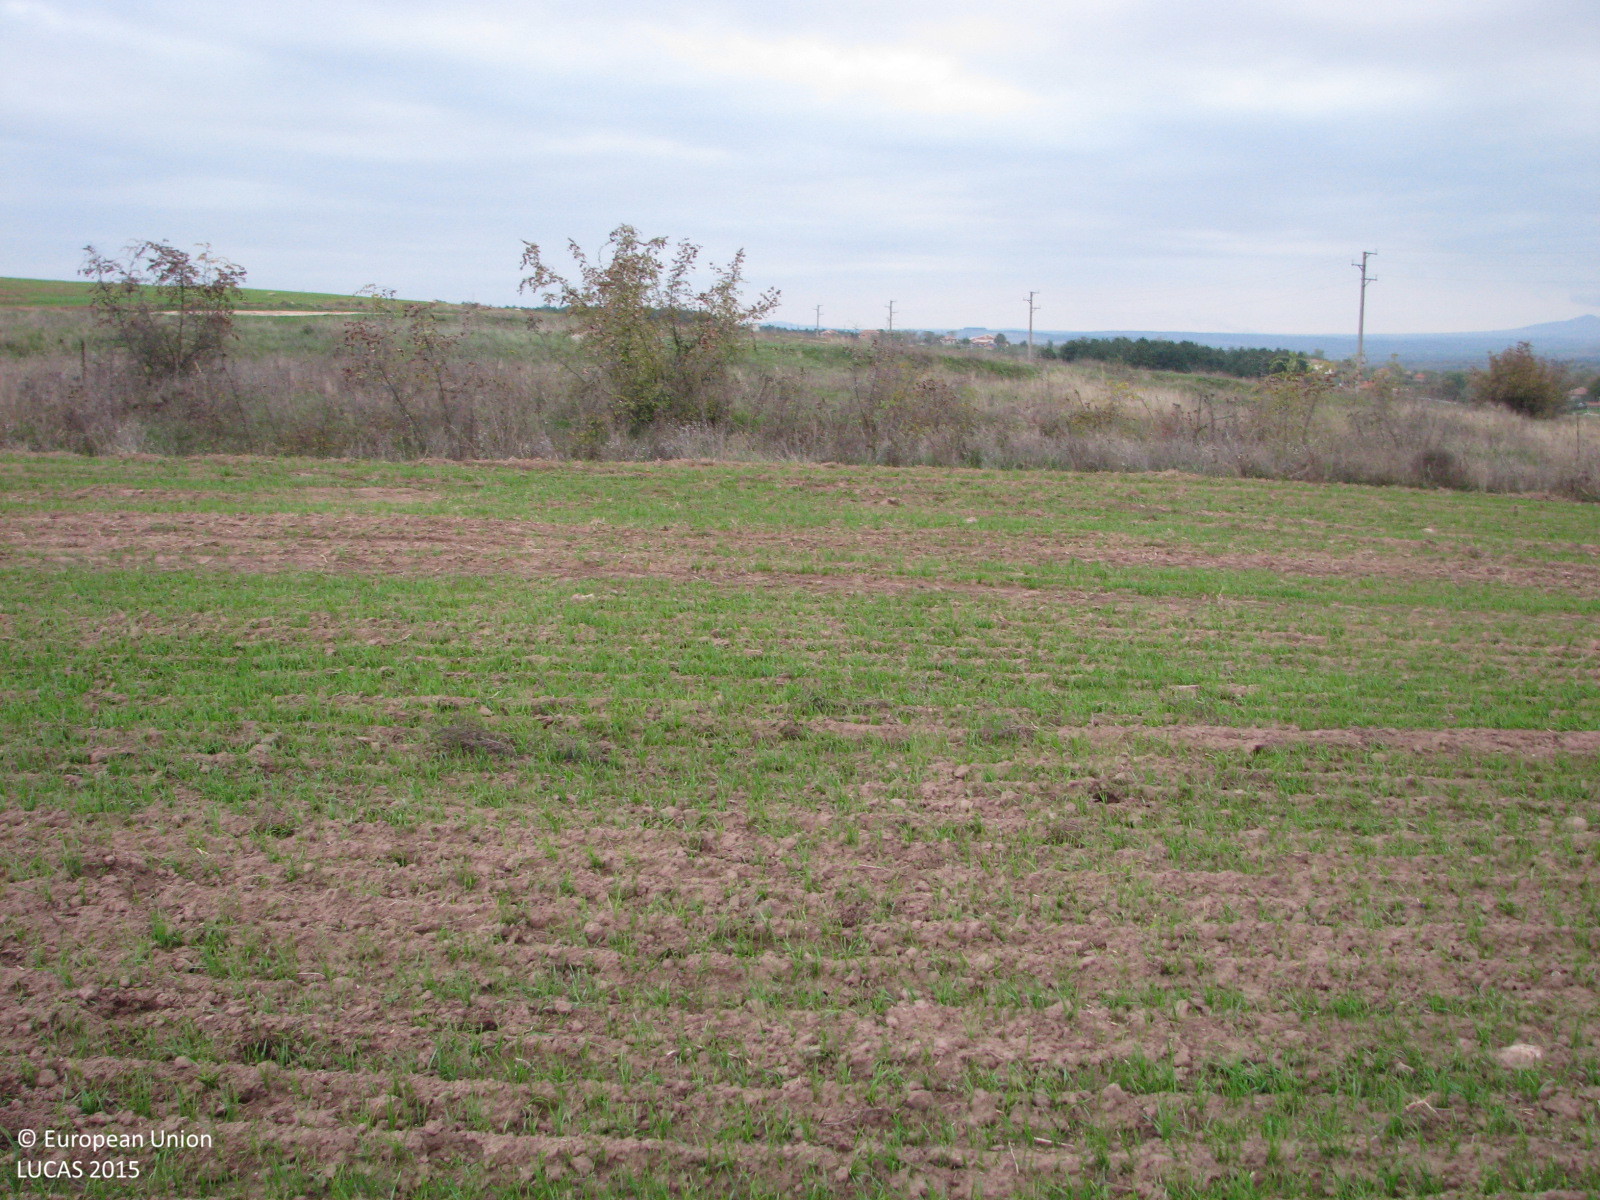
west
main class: Cropland
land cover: Common wheat
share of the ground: 25 - 50 %
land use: Agriculture (excluding fallow land and kitchen gardens)
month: October
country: BG
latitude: 42.0921
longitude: 26.5428
